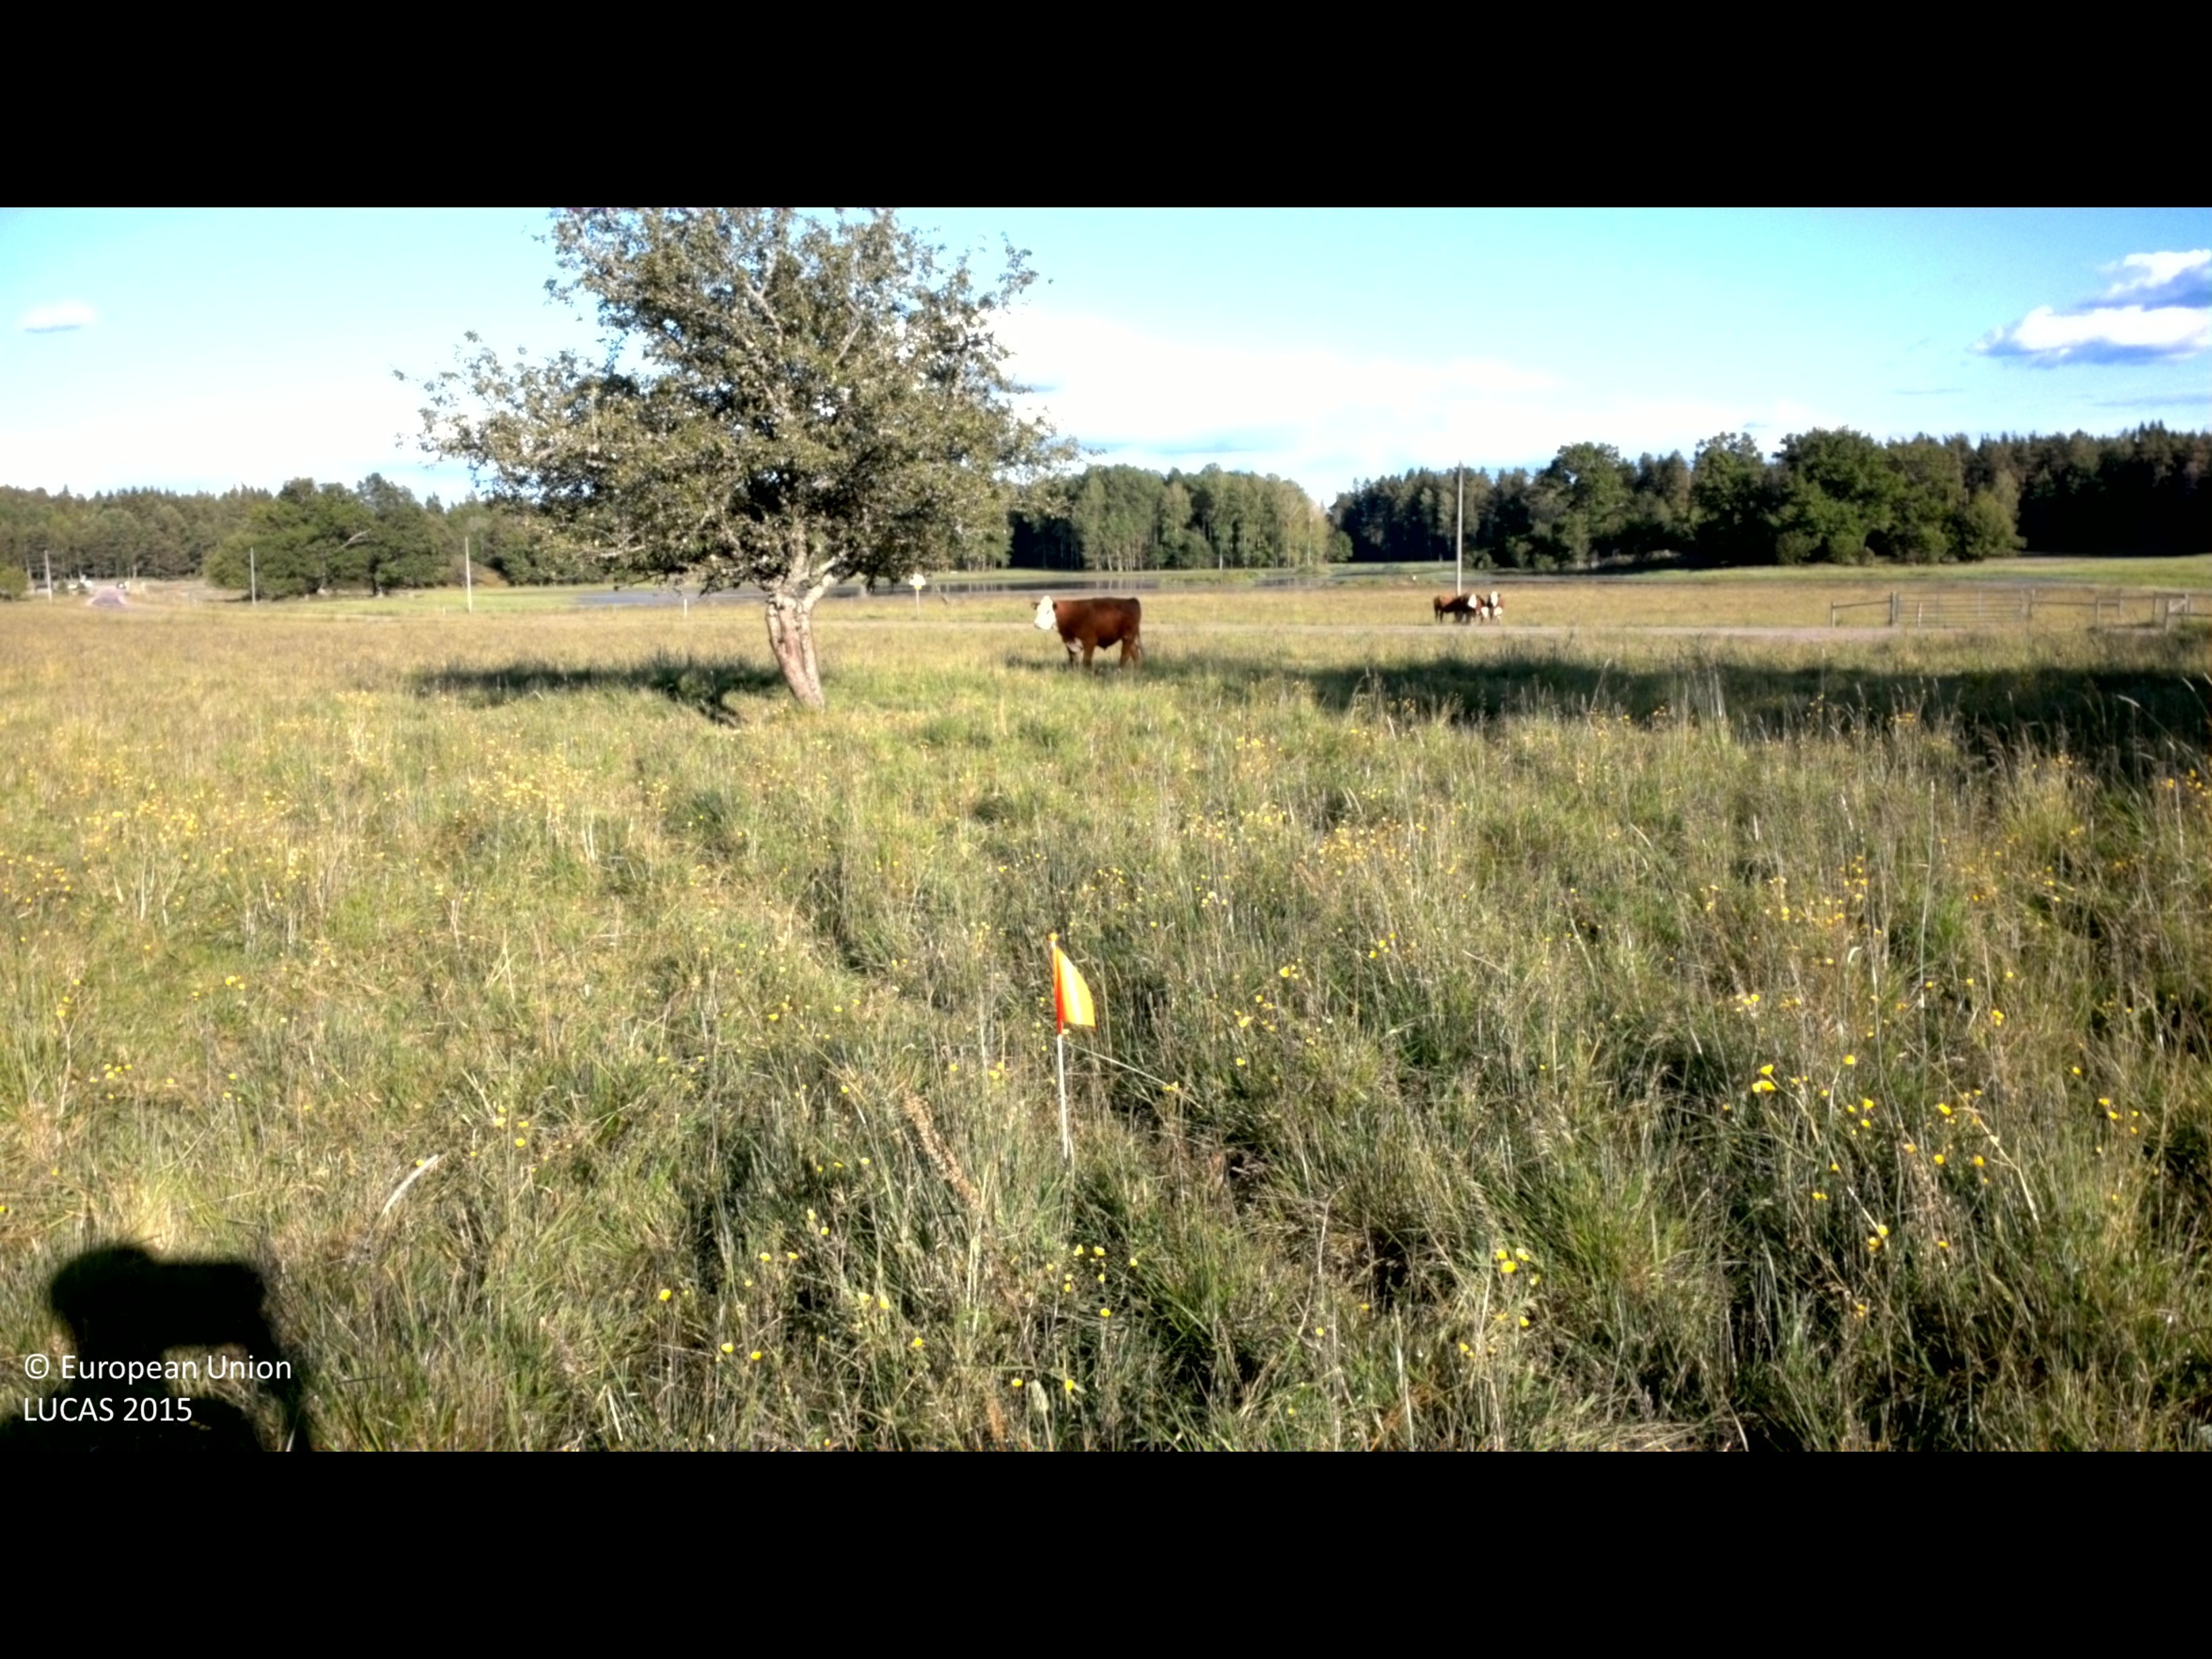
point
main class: Grassland
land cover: Grassland with sparse tree/shrub cover
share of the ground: > 75 %
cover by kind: herbaceous plants 95 %, broadleaved forest trees 5 %
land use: Agriculture (excluding fallow land and kitchen gardens)
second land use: Amenities, museums, leisure
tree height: > 5 m
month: June
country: SE
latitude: 58.3726
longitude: 15.6197
